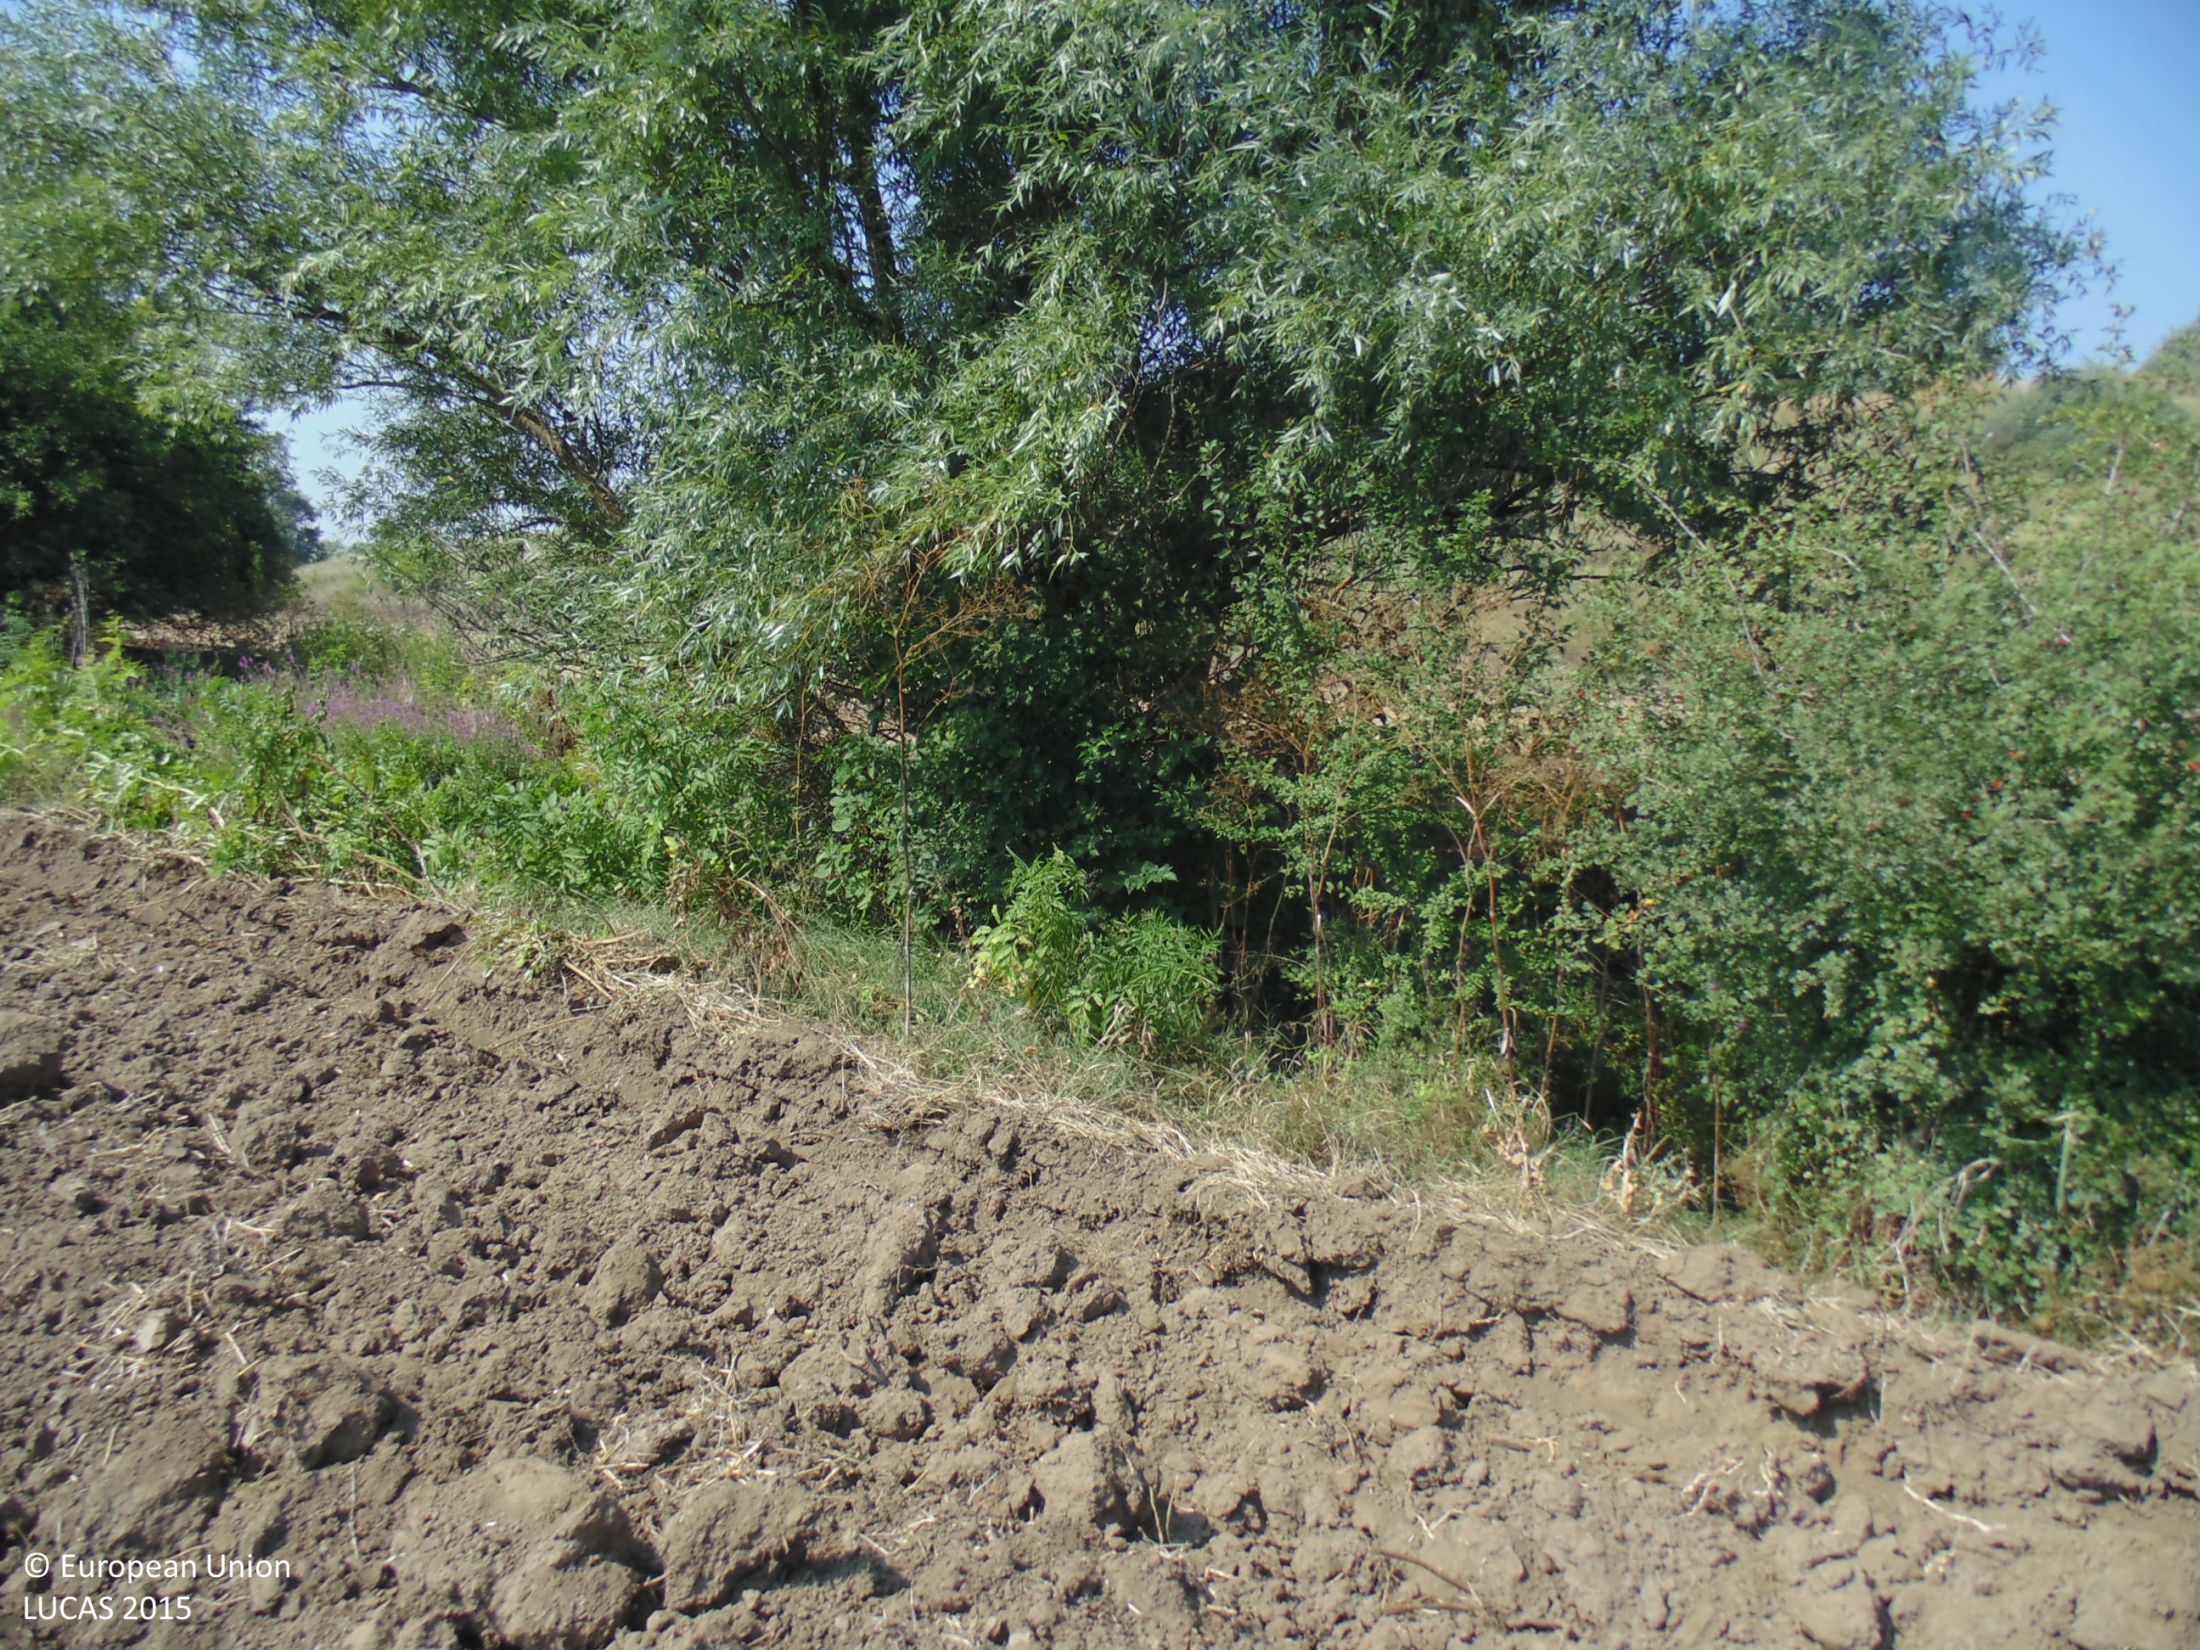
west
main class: Cropland
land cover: Common wheat
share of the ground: < 10 %
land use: Agriculture (excluding fallow land and kitchen gardens)
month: August
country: BG
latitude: 44.0412
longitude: 27.3167
